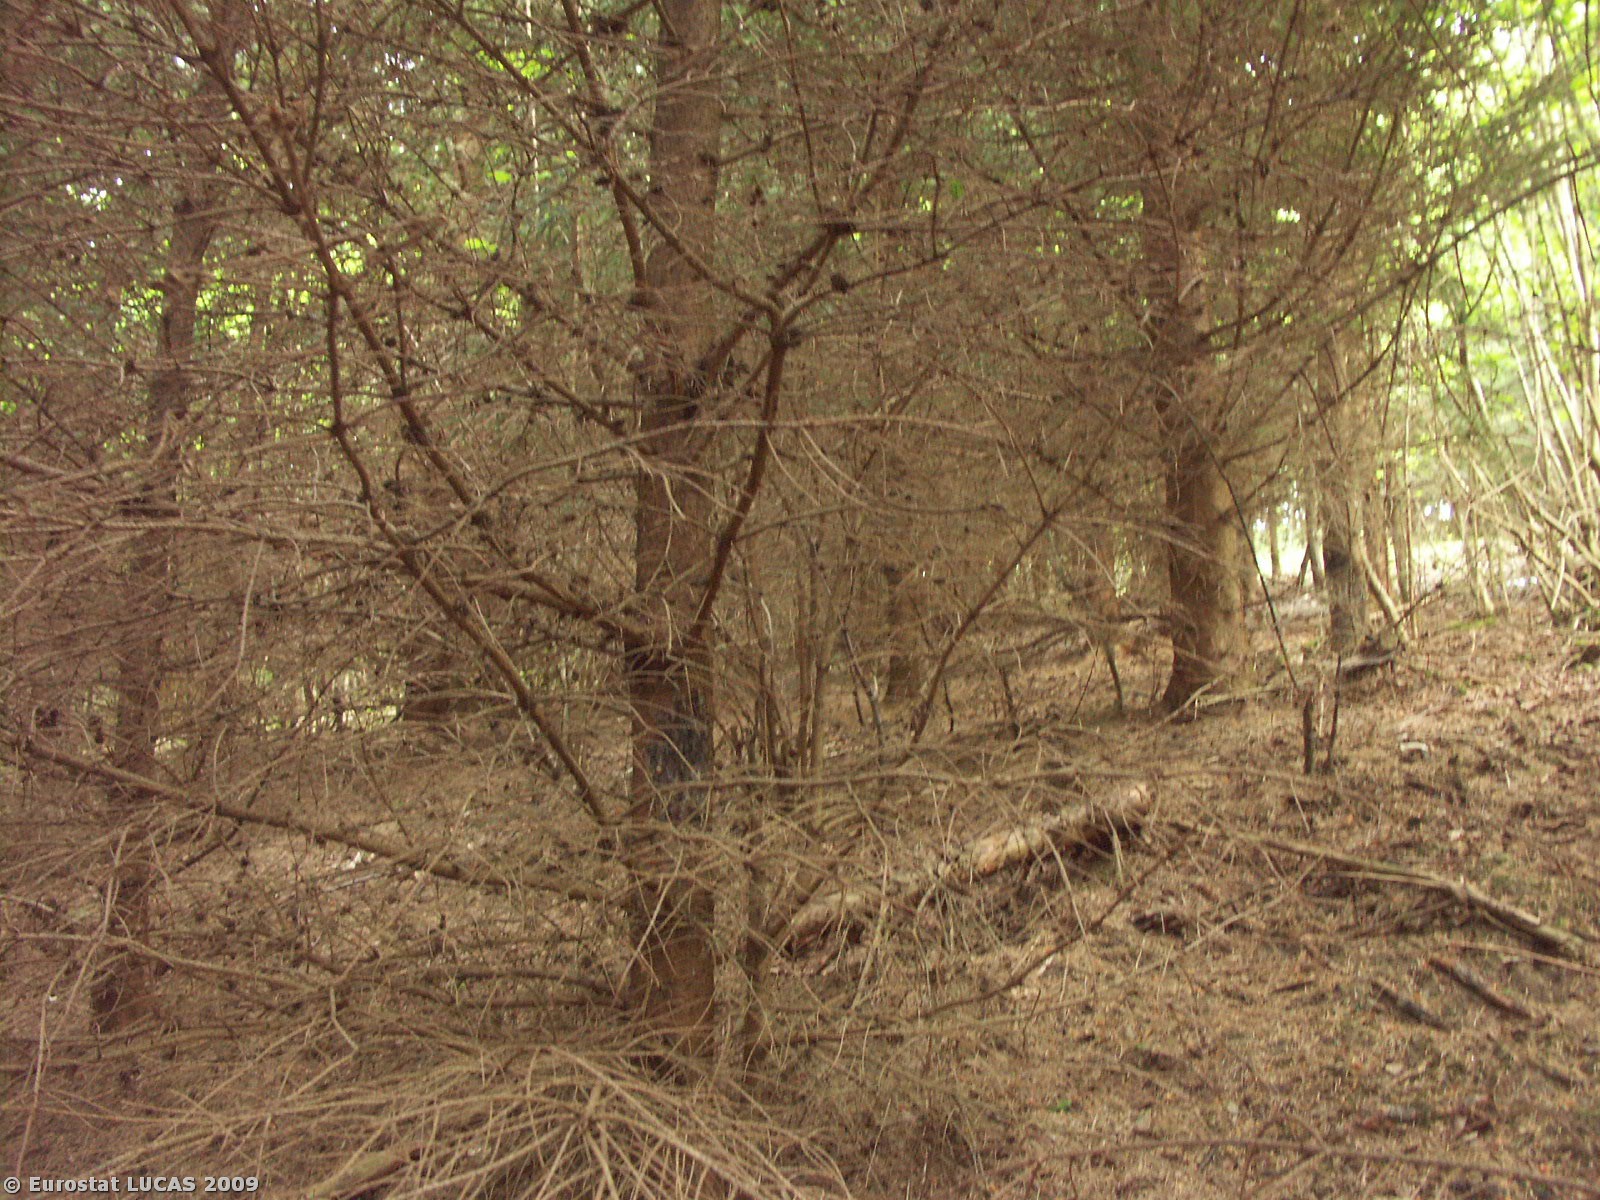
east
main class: Woodland
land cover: Coniferous woodland
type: hemiboreal forest and nemoral coniferous forest and mixed broadleaved-coniferous forest
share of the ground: > 75 %
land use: Forestry
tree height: > 5 m
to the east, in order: Coniferous woodland; Broadleaved woodland; Grassland without tree/shrub cover
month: May
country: CZ
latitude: 48.6860
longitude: 14.6059
